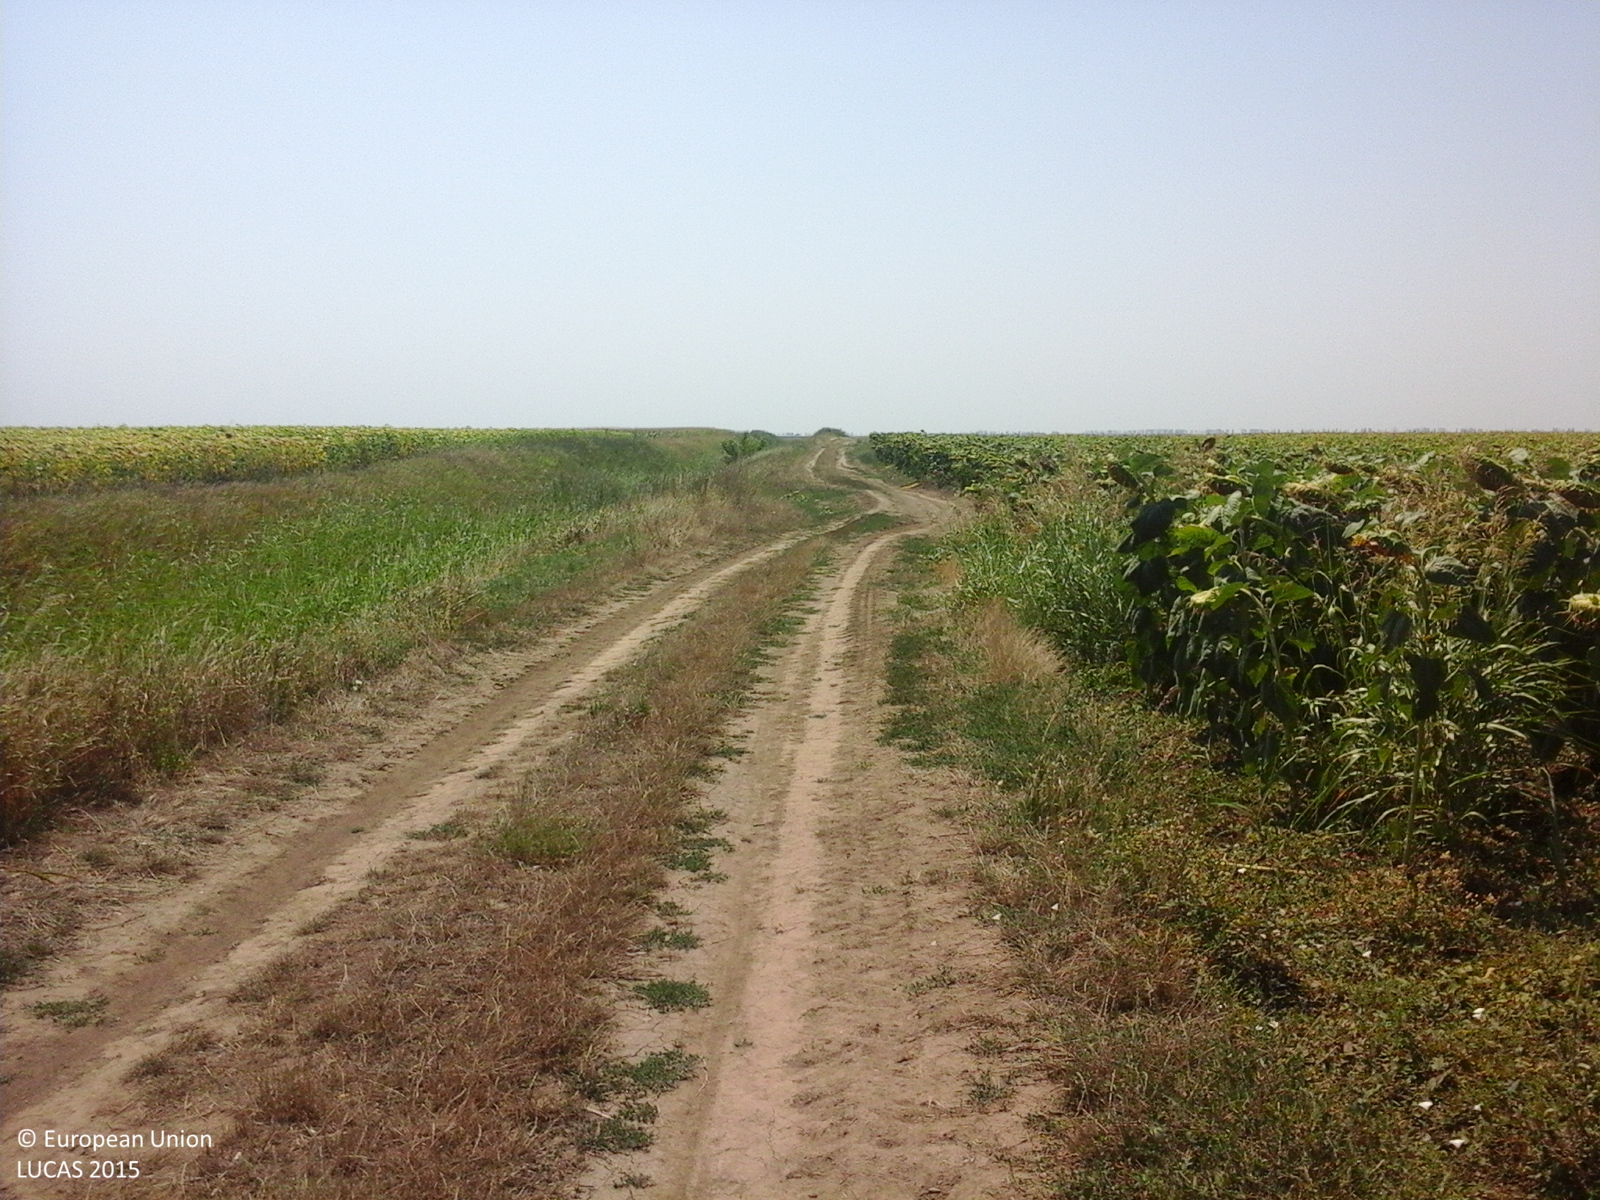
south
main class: Cropland
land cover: Sunflower
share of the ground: > 75 %
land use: Agriculture (excluding fallow land and kitchen gardens)
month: August
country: RO
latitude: 44.9325
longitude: 26.7120
